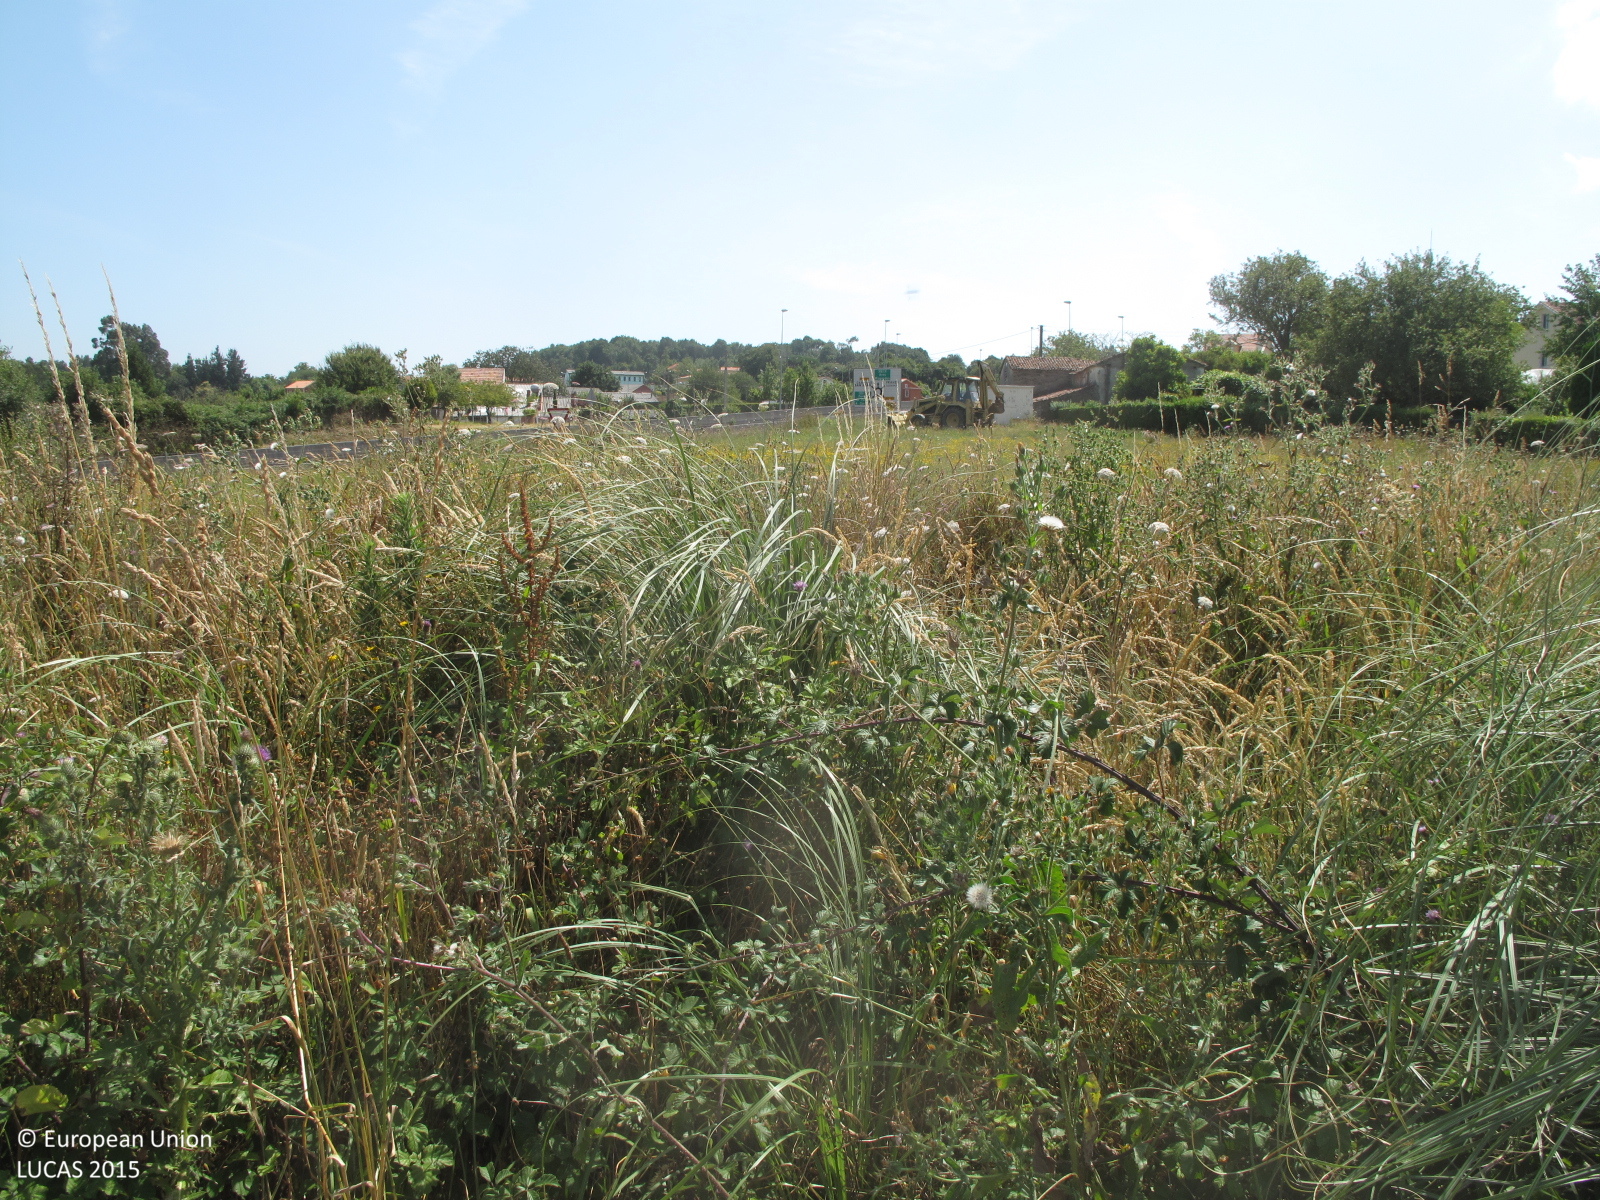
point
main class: Shrubland
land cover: Shrubland without tree cover
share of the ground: 25 - 50 %
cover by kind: herbaceous plants 70 %, shrubs 30 %
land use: Abandoned areas
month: July
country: ES
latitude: 43.4435
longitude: -8.2030
